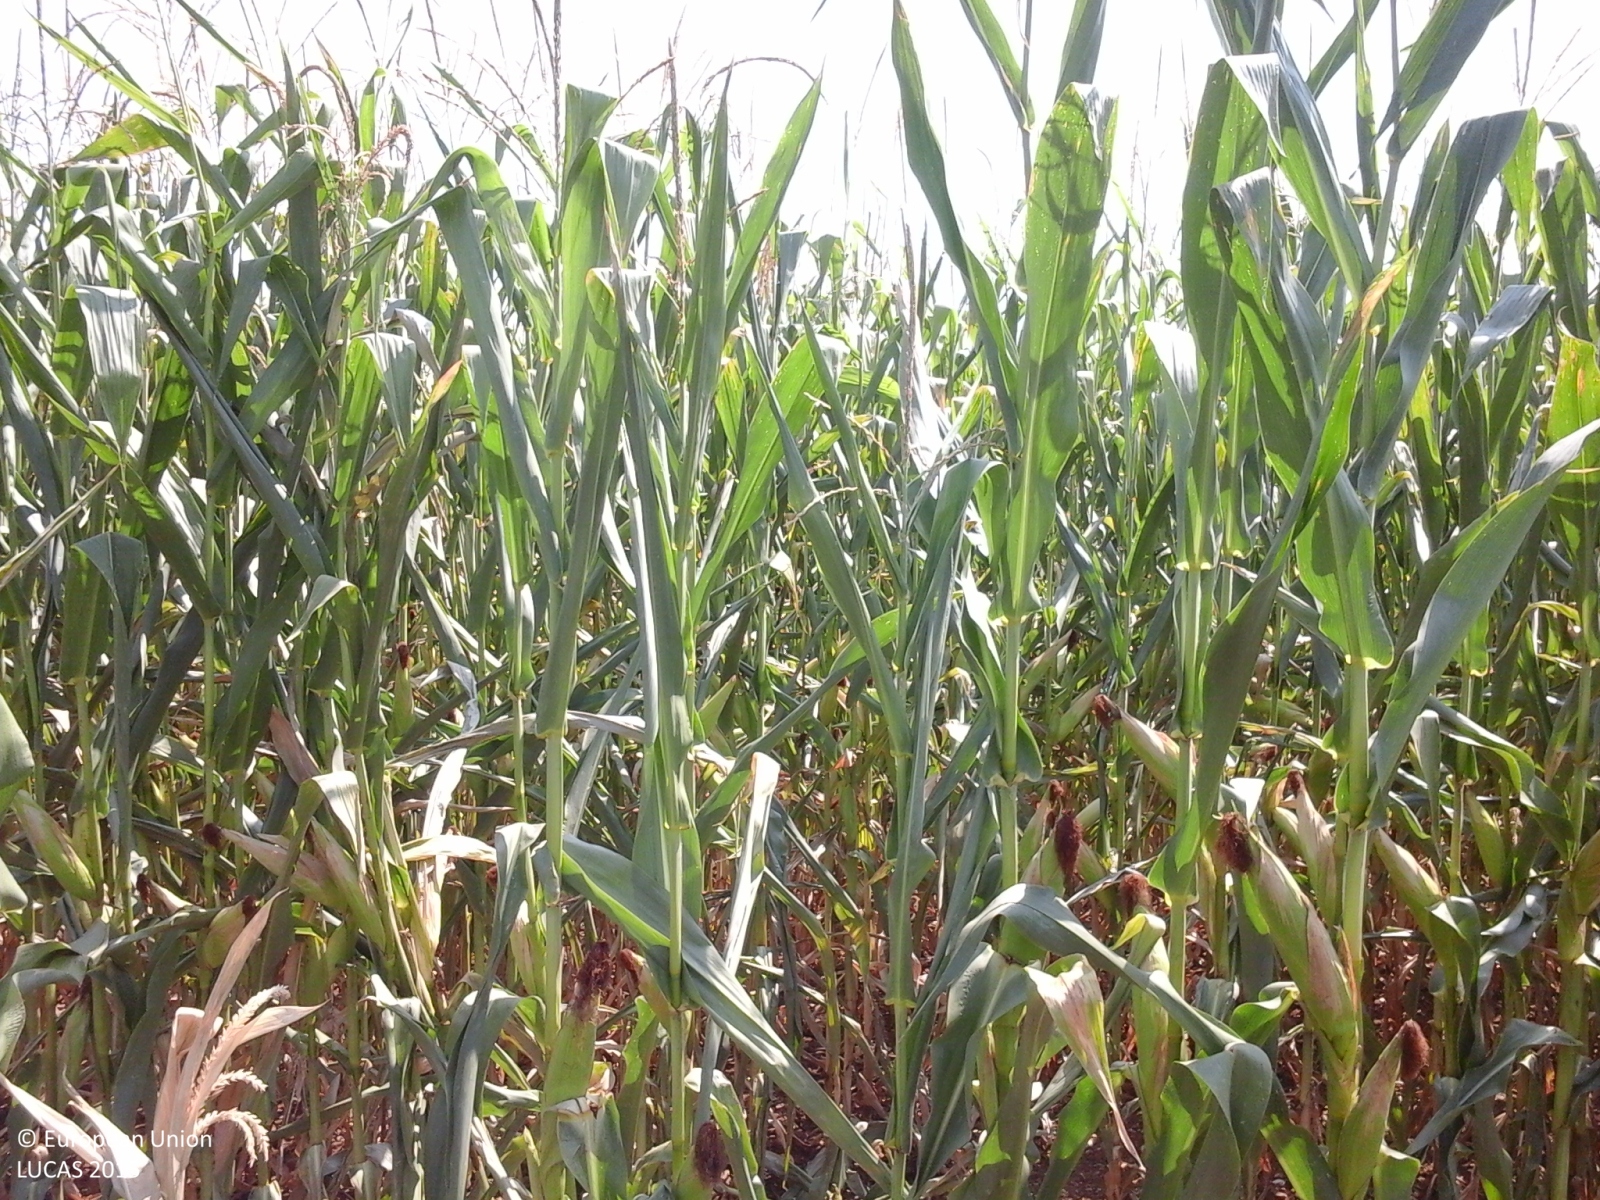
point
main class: Cropland
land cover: Maize
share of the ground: > 75 %
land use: Agriculture (excluding fallow land and kitchen gardens)
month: July
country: IT
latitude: 45.8579
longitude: 12.3023
